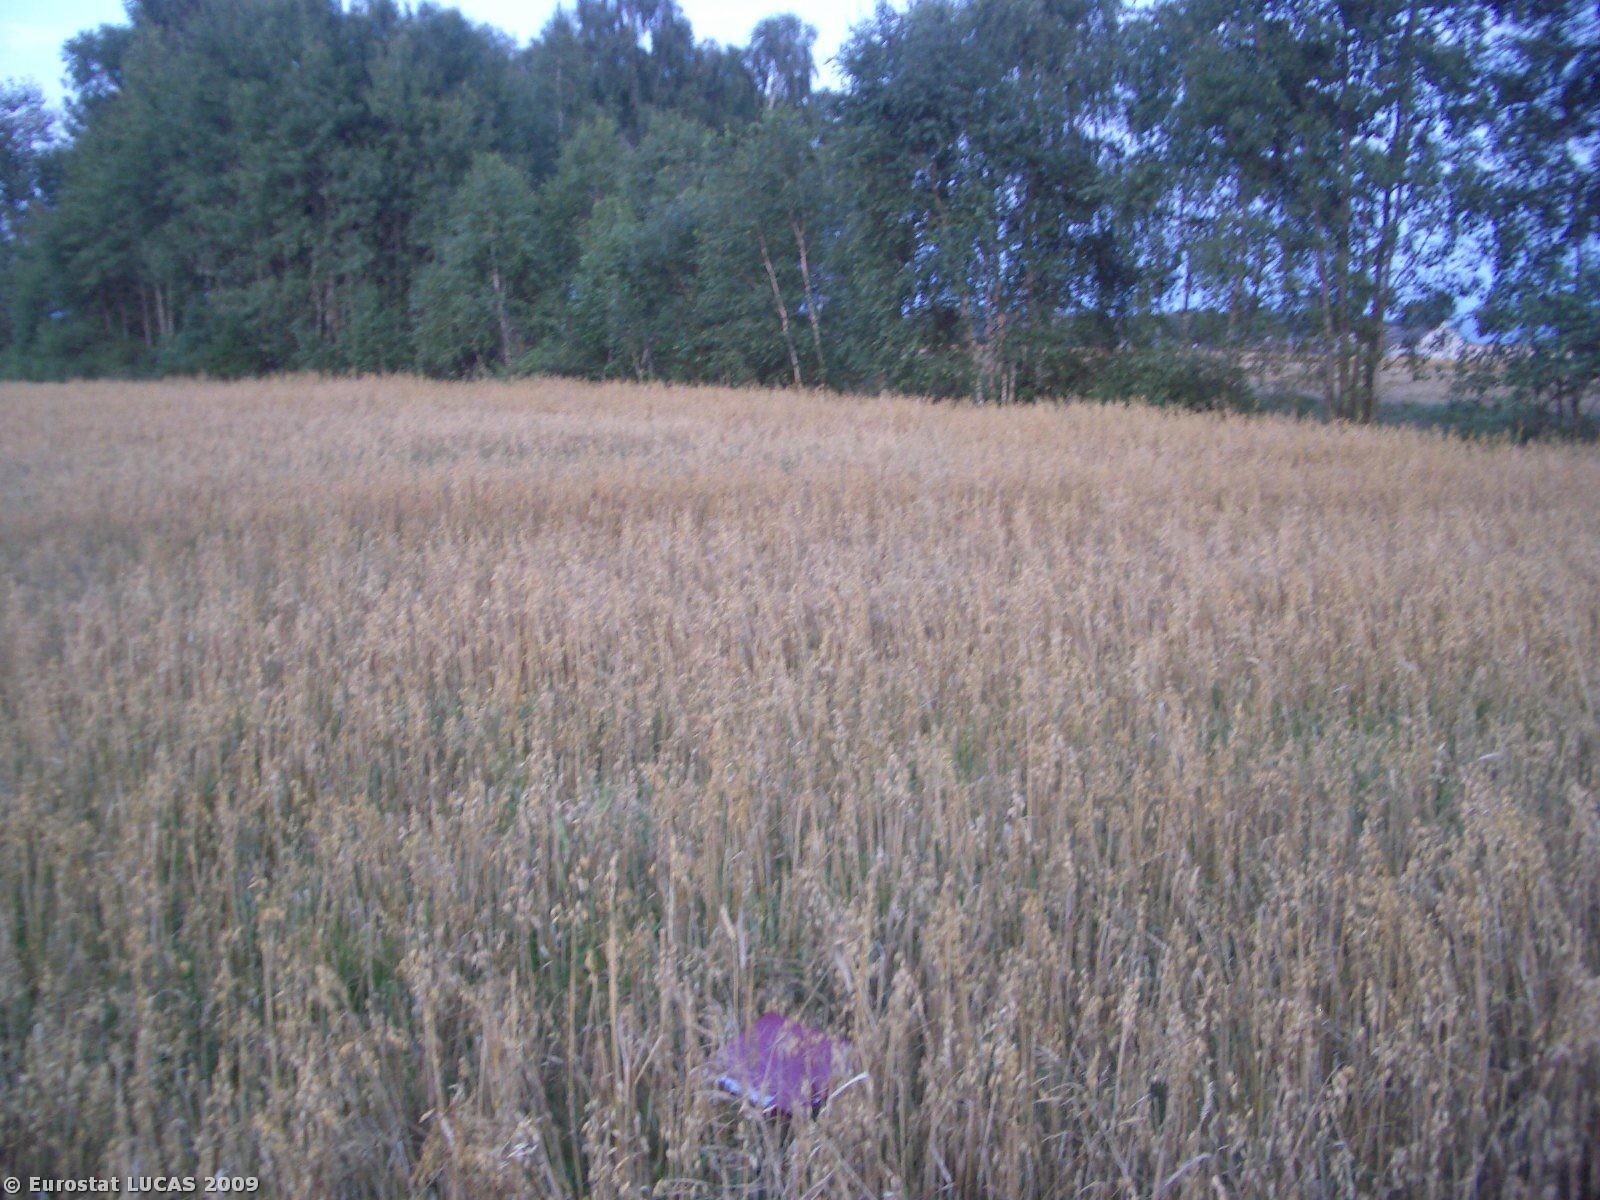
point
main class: Cropland
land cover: Oats
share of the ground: 50 - 75 %
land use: Agriculture (excluding fallow land and kitchen gardens)
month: August
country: PL
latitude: 51.8352
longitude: 23.2128
